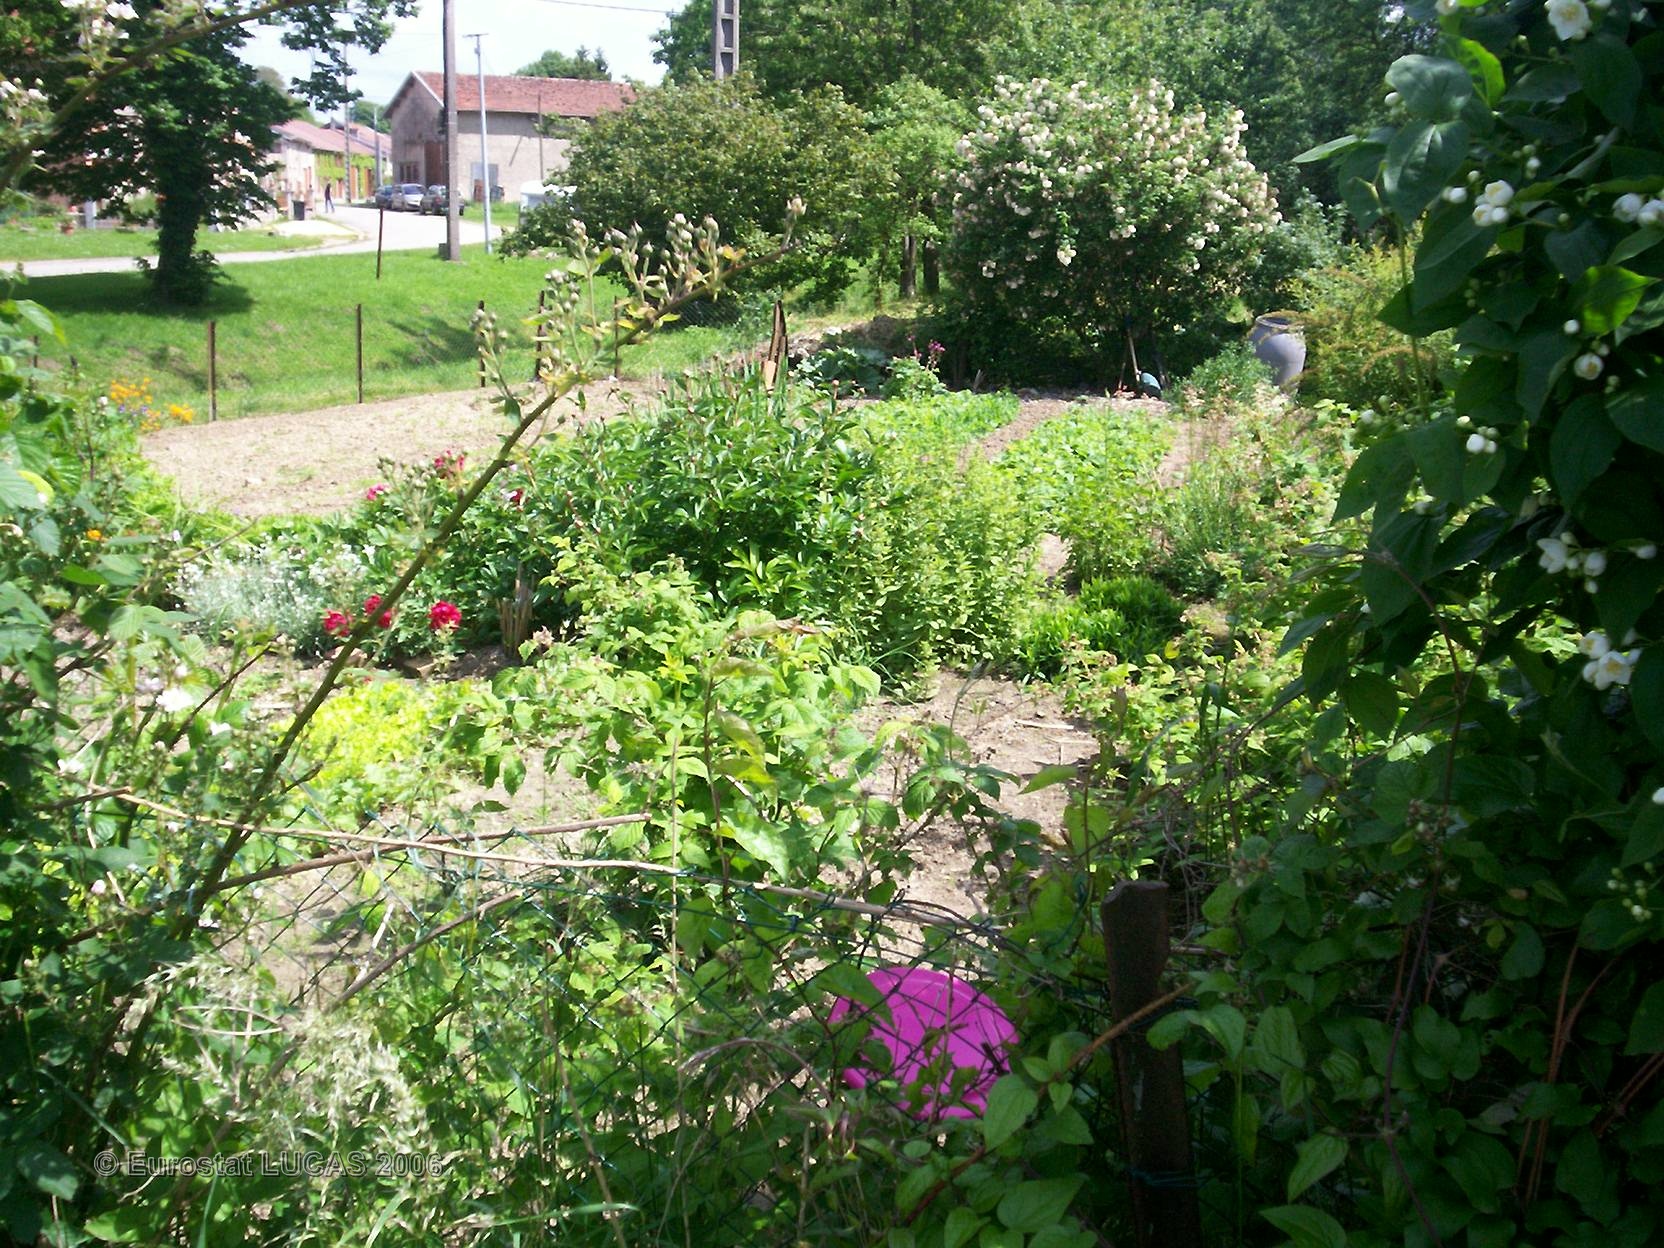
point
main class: Cropland
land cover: Other fresh vegetables
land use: Kitchen garden
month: June
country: FR
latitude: 49.2486
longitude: 5.0661
